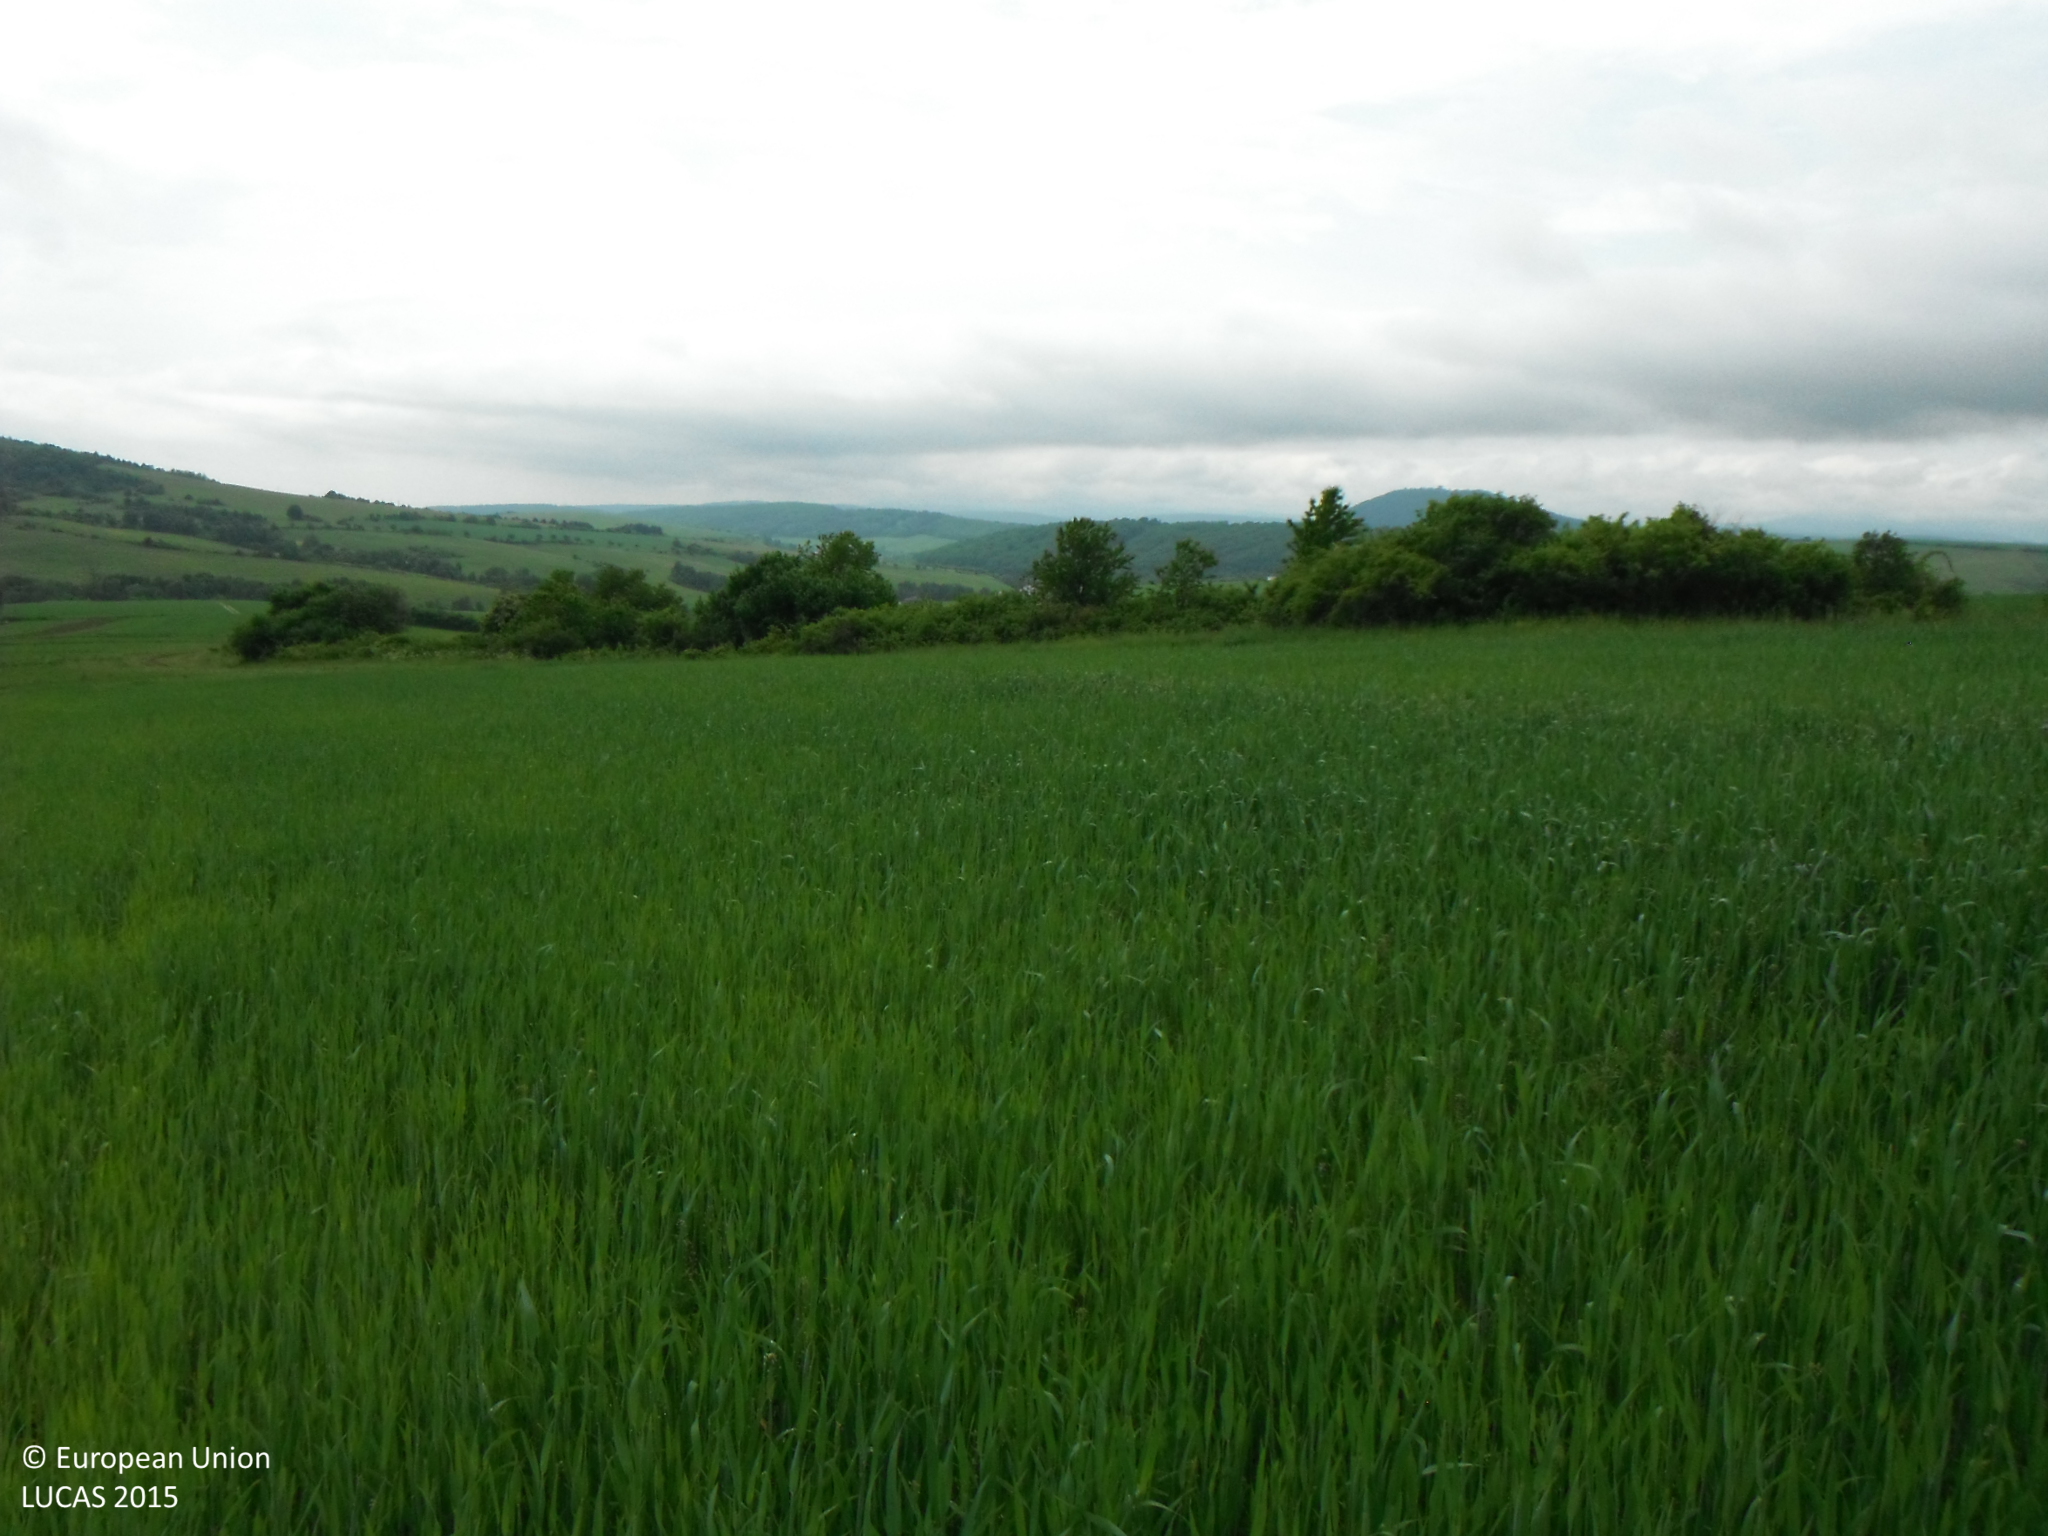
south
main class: Cropland
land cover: Common wheat
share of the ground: > 75 %
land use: Agriculture (excluding fallow land and kitchen gardens)
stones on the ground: < 10 %
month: May
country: SK
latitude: 49.1030
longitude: 21.2080
